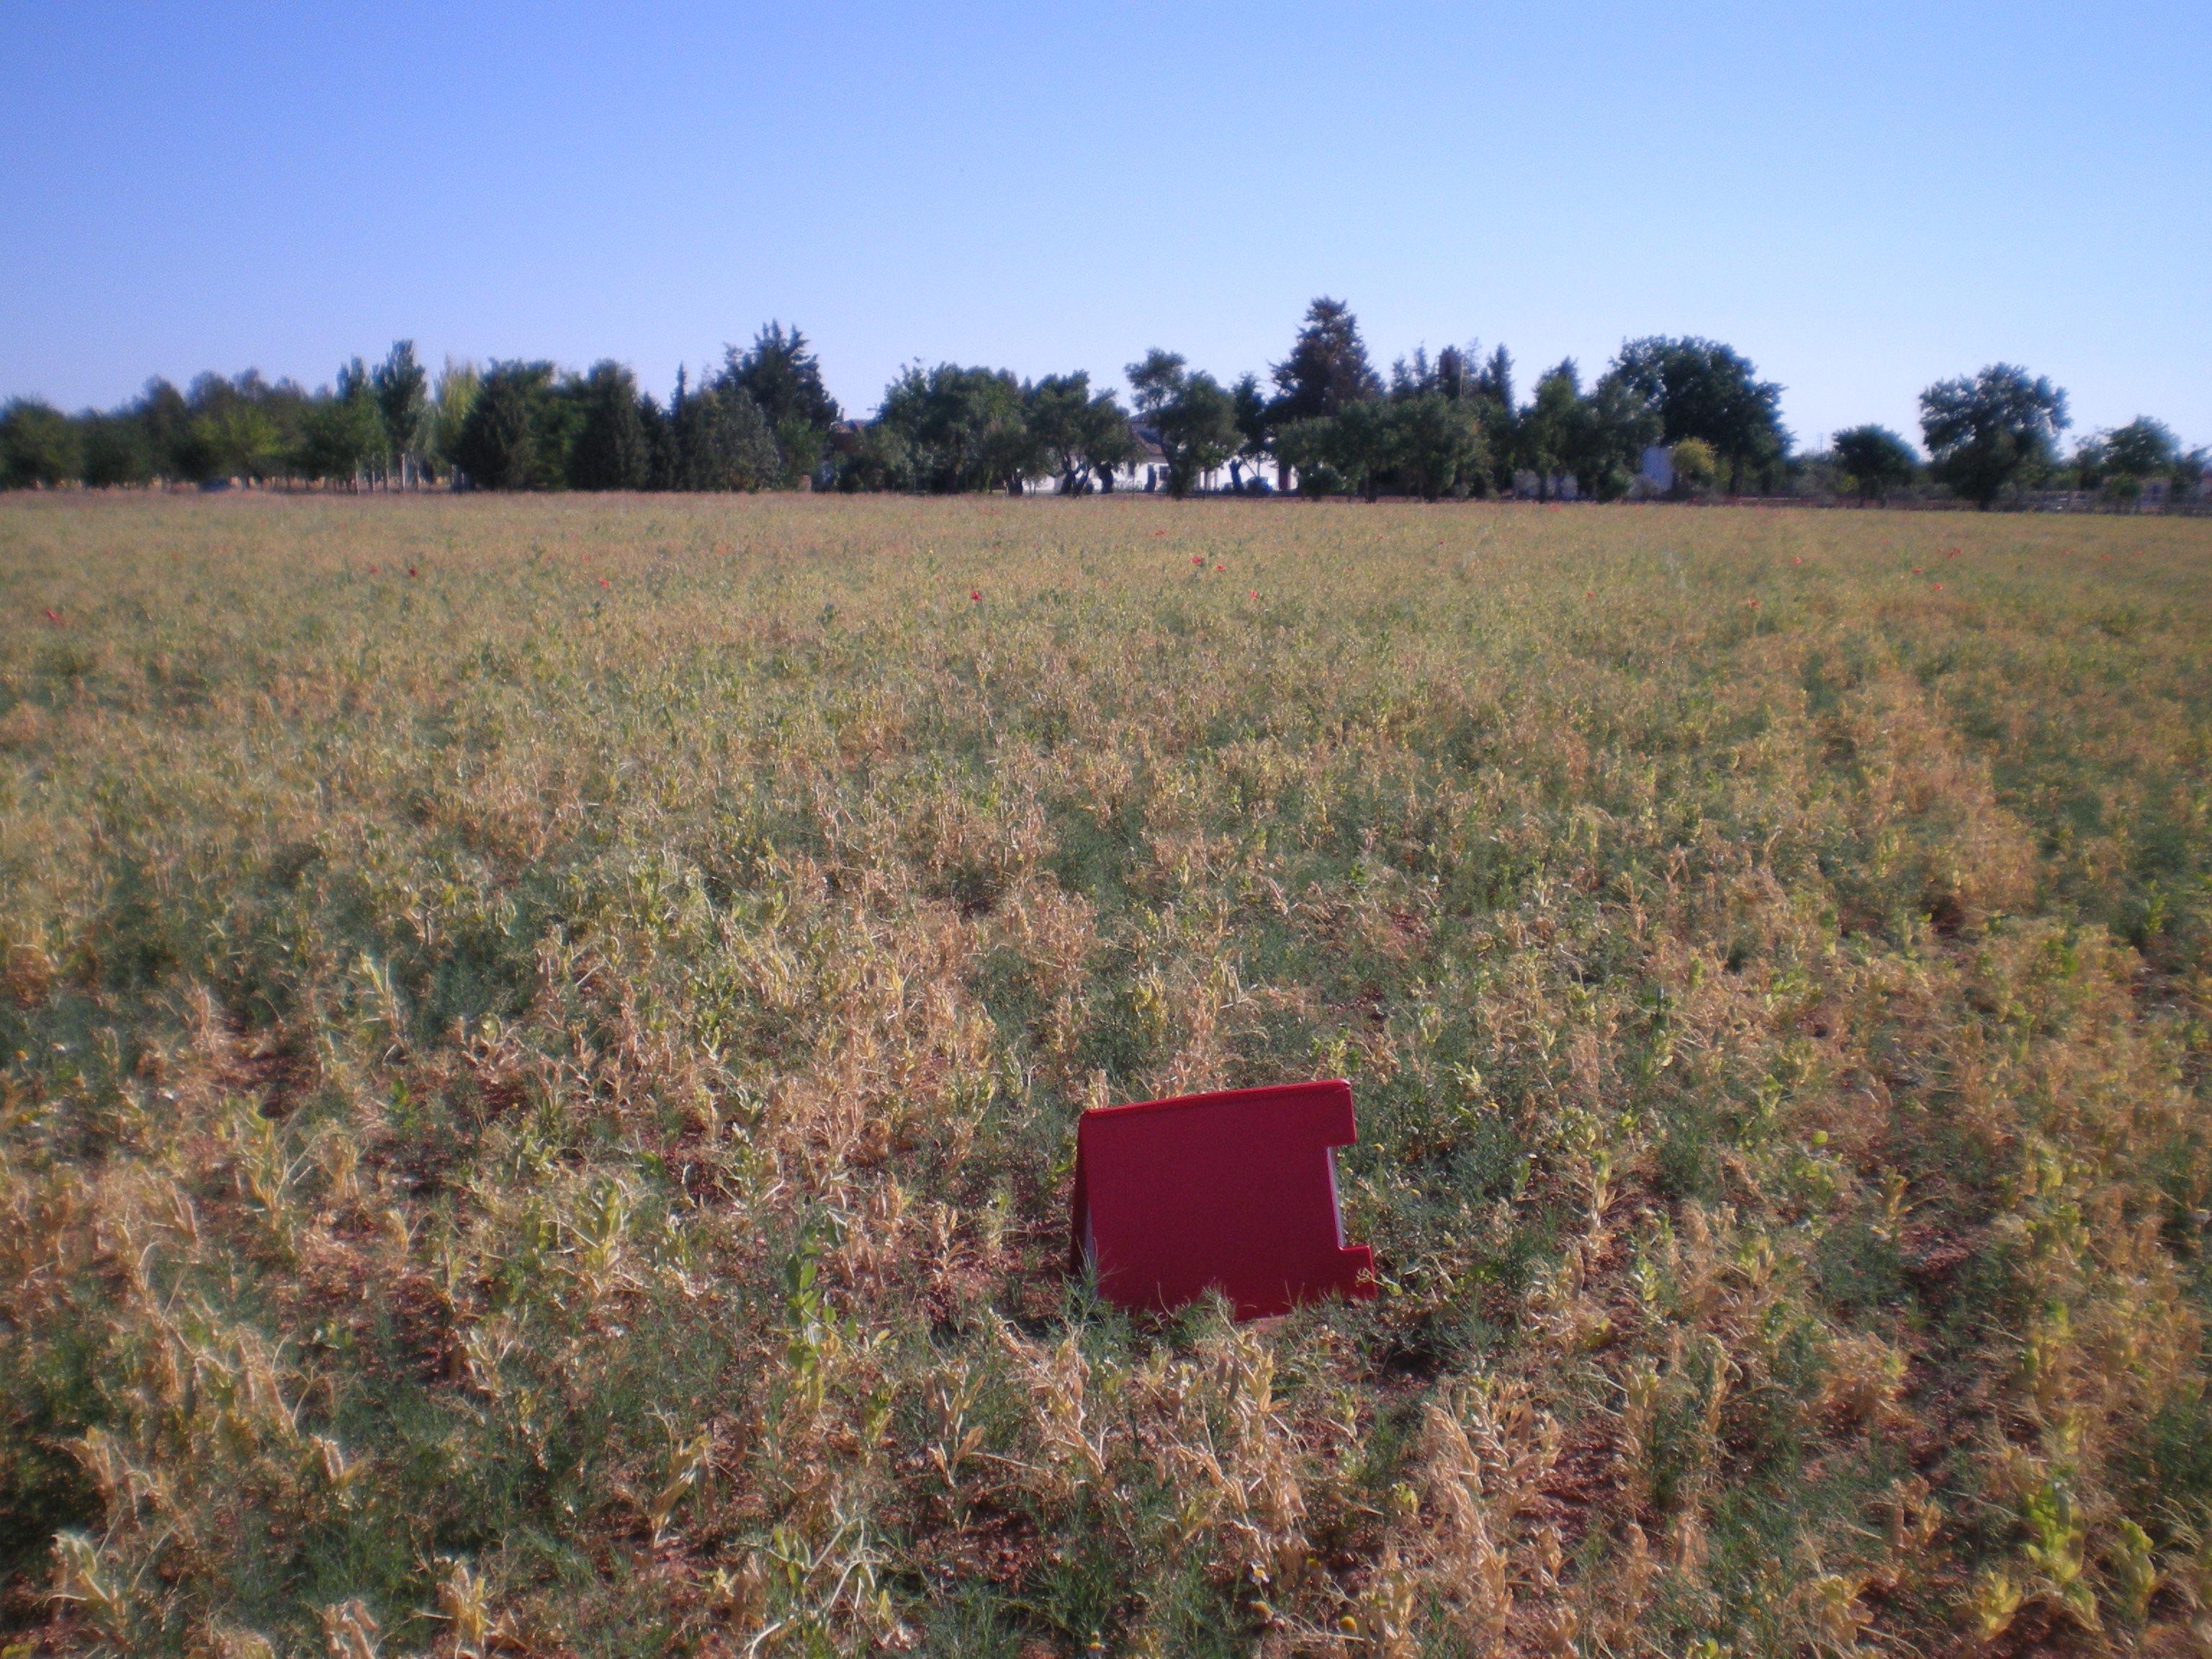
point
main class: Cropland
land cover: Dry pulses
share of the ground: 50 - 75 %
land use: Agriculture (excluding fallow land and kitchen gardens)
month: May
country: ES
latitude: 39.1009
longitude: -3.3009
